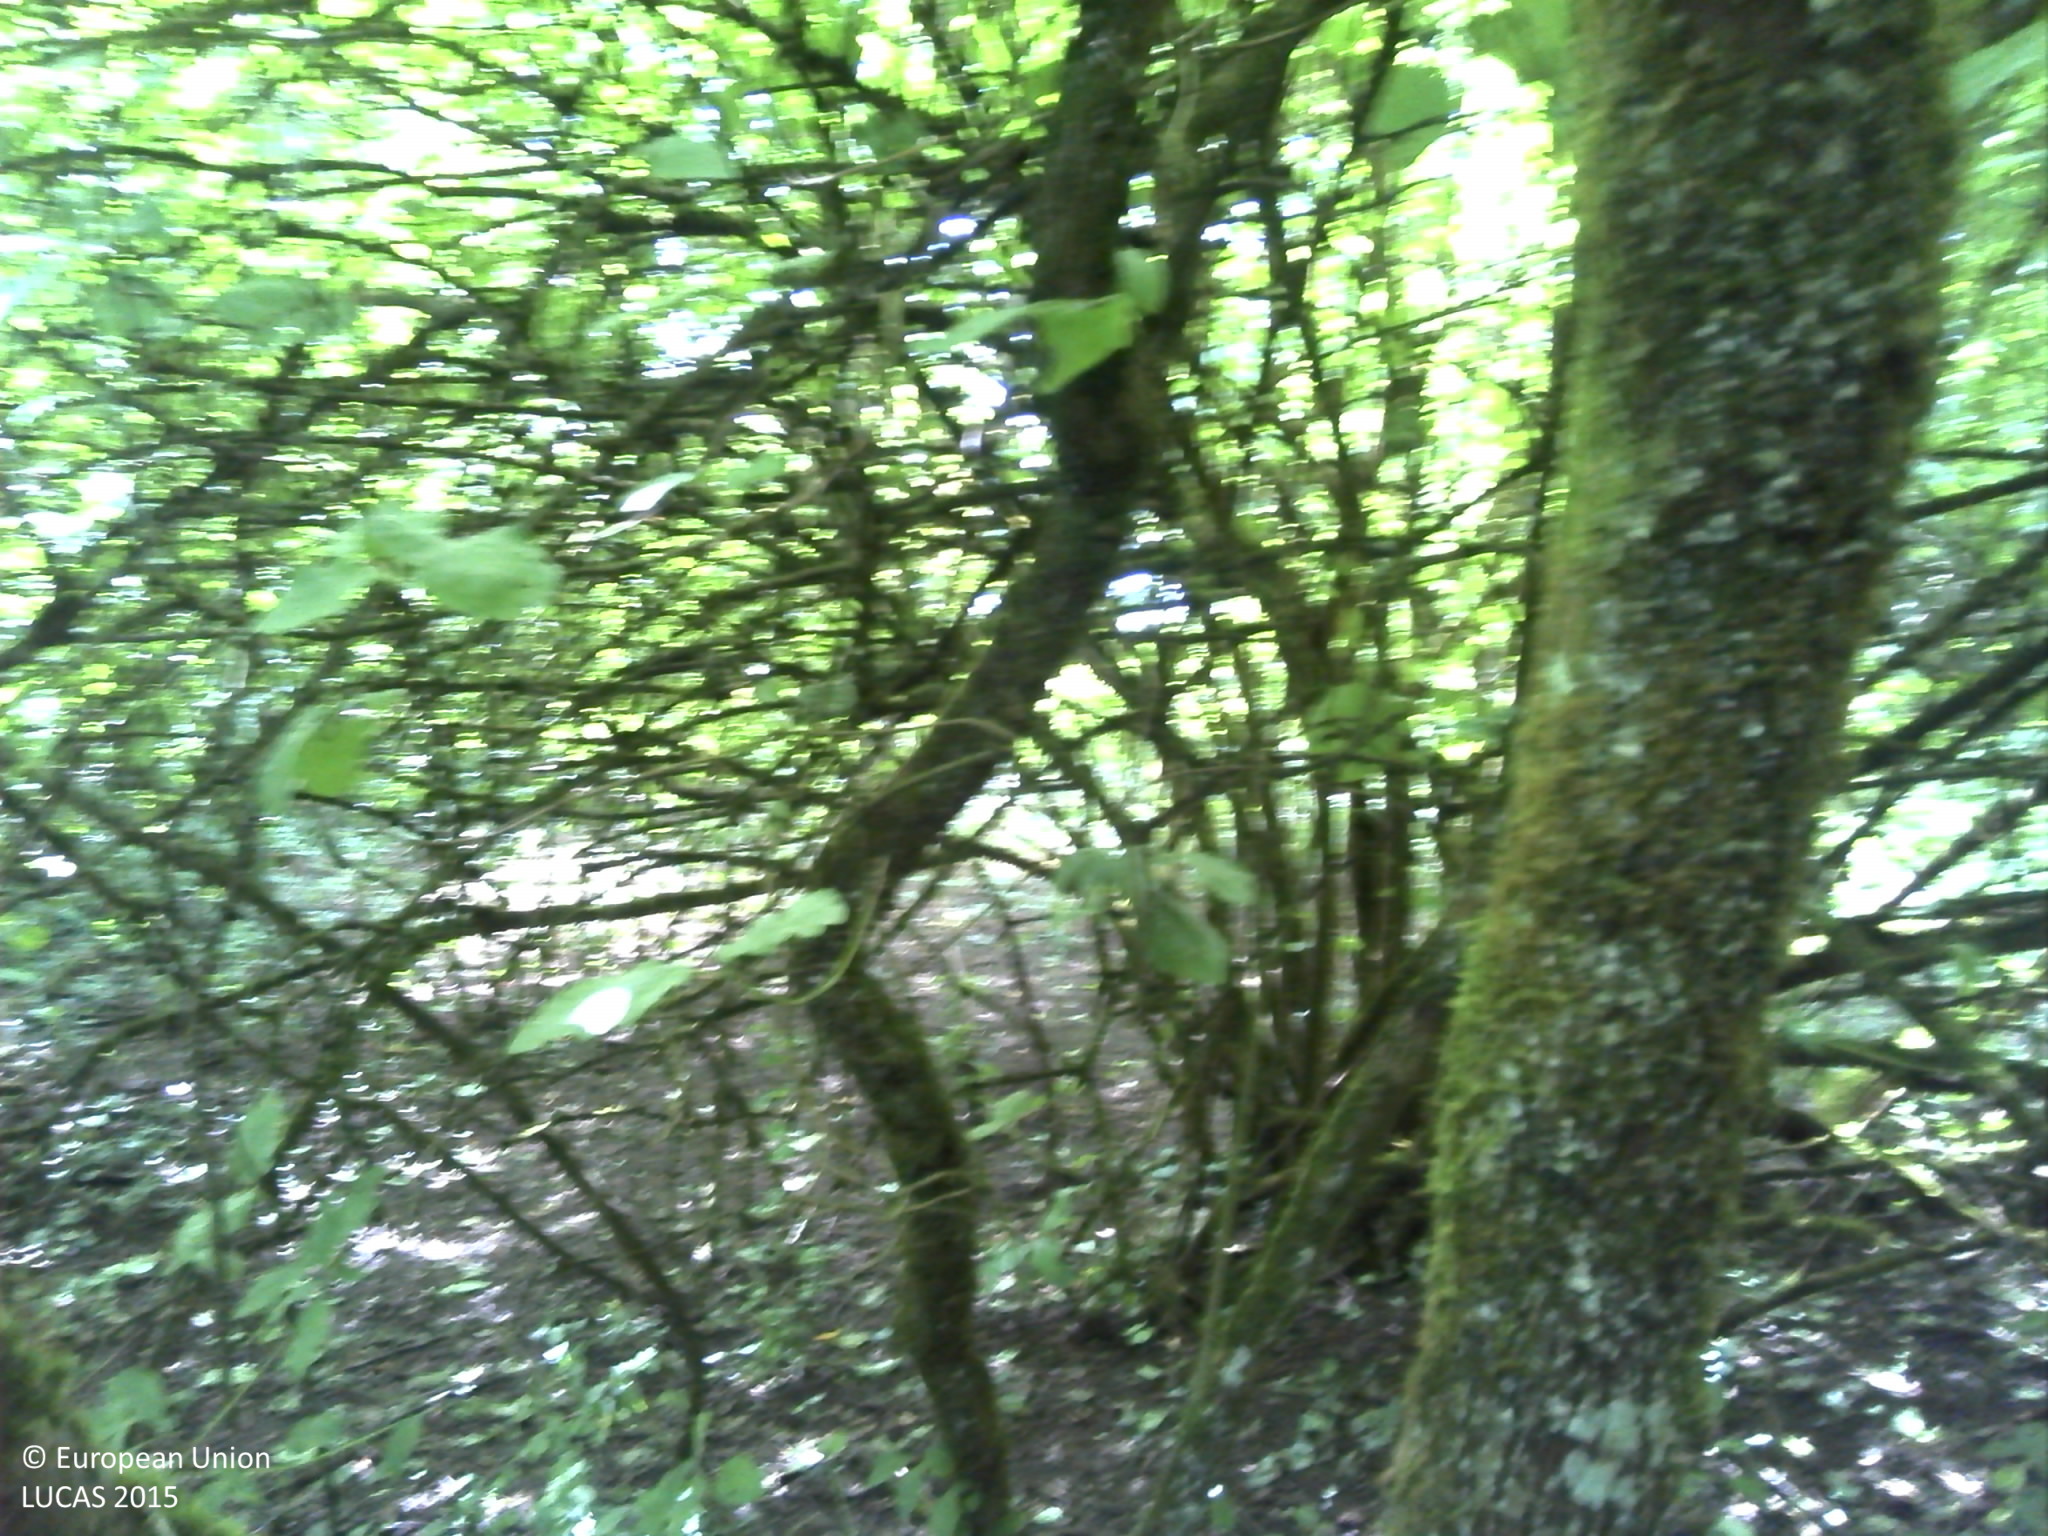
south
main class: Woodland
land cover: Broadleaved woodland
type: non-riverine alder, birch or aspen forest
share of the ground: > 75 %
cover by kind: broadleaved forest trees 90 %, shrubs 10 %
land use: Semi-natural and natural areas not in use
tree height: > 5 m
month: June
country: FR
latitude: 49.2527
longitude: 6.0840
